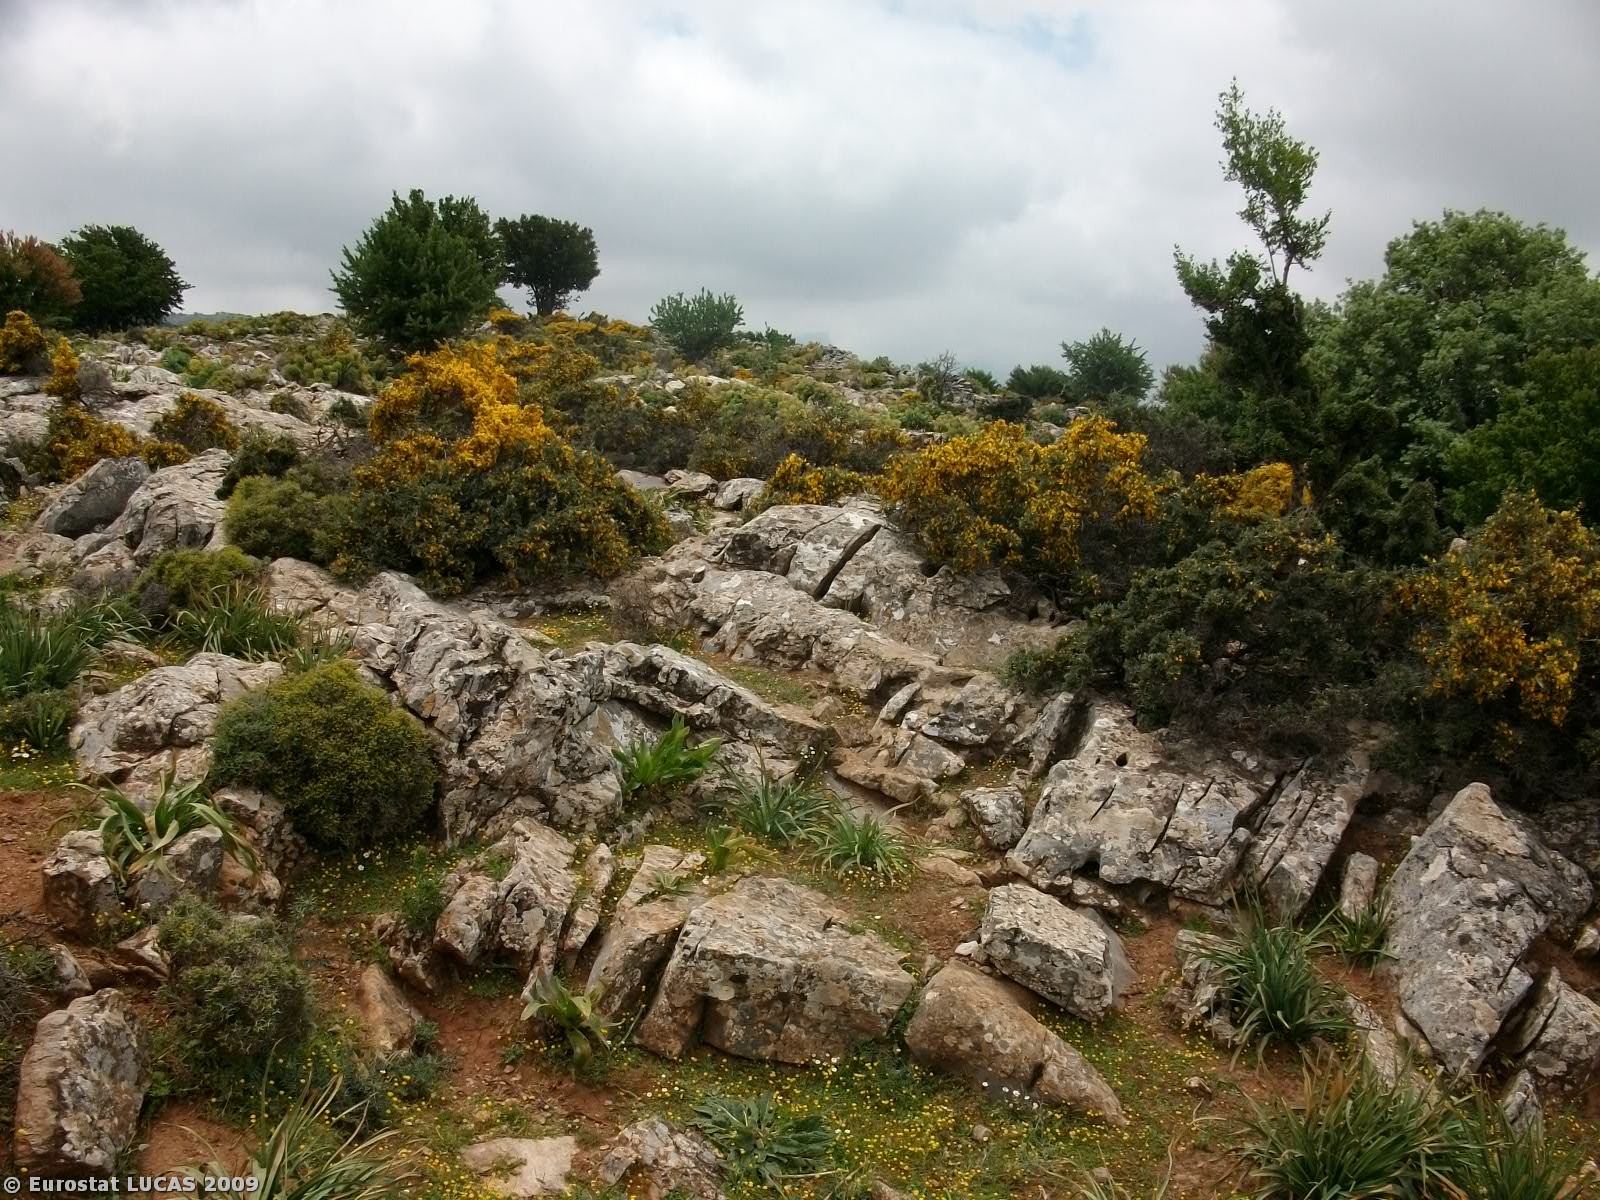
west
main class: Shrubland
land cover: Shrubland with sparse tree cover
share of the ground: > 75 %
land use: Agriculture (excluding fallow land and kitchen gardens)
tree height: < 5 m
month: May
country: GR
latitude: 35.2792
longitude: 24.8867
